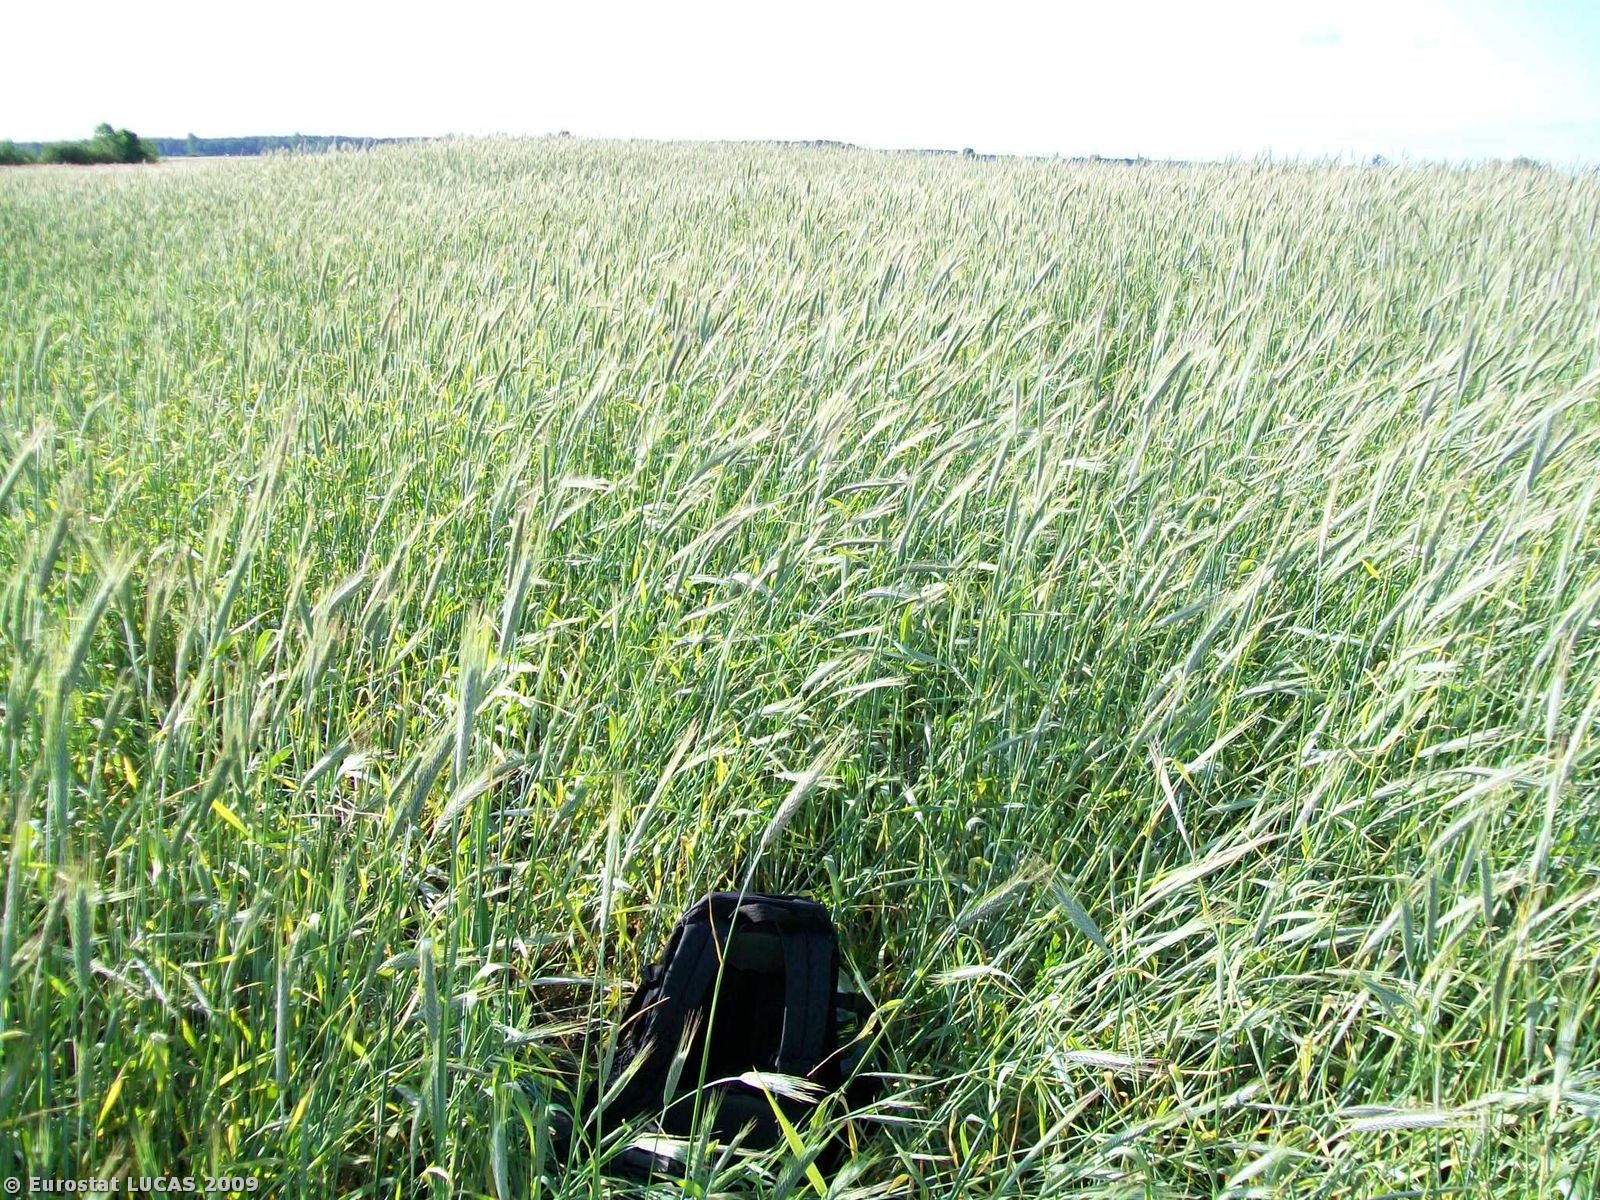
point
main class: Cropland
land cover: Rye
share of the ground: > 75 %
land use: Agriculture (excluding fallow land and kitchen gardens)
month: May
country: PL
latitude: 52.0141
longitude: 16.2574
